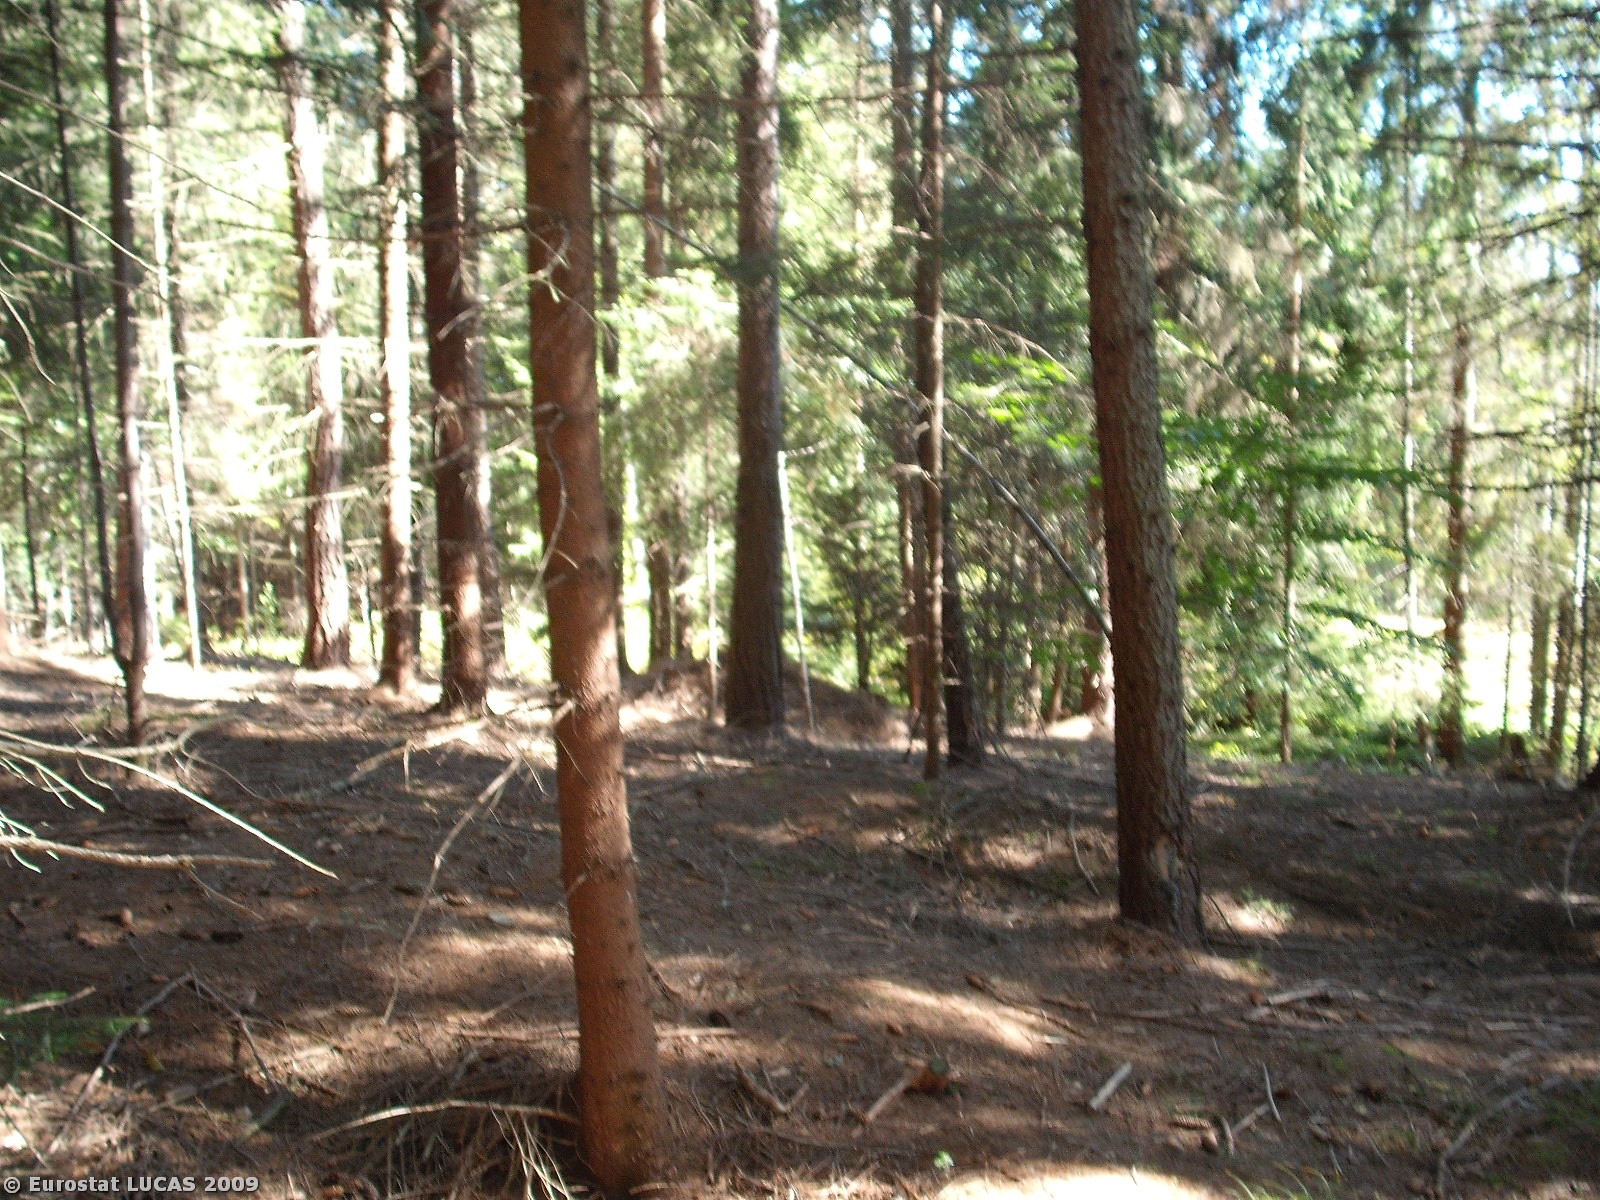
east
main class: Woodland
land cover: Coniferous woodland
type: hemiboreal forest and nemoral coniferous forest and mixed broadleaved-coniferous forest
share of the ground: > 75 %
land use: Forestry
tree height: > 5 m
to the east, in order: Coniferous woodland; Tracks; Coniferous woodland; Paved roads, cycling and walking lanes; Mixed woodland; Coniferous woodland; Ditches and canals; Coniferous woodland
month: September
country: PL
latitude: 49.5602
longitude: 19.6085
